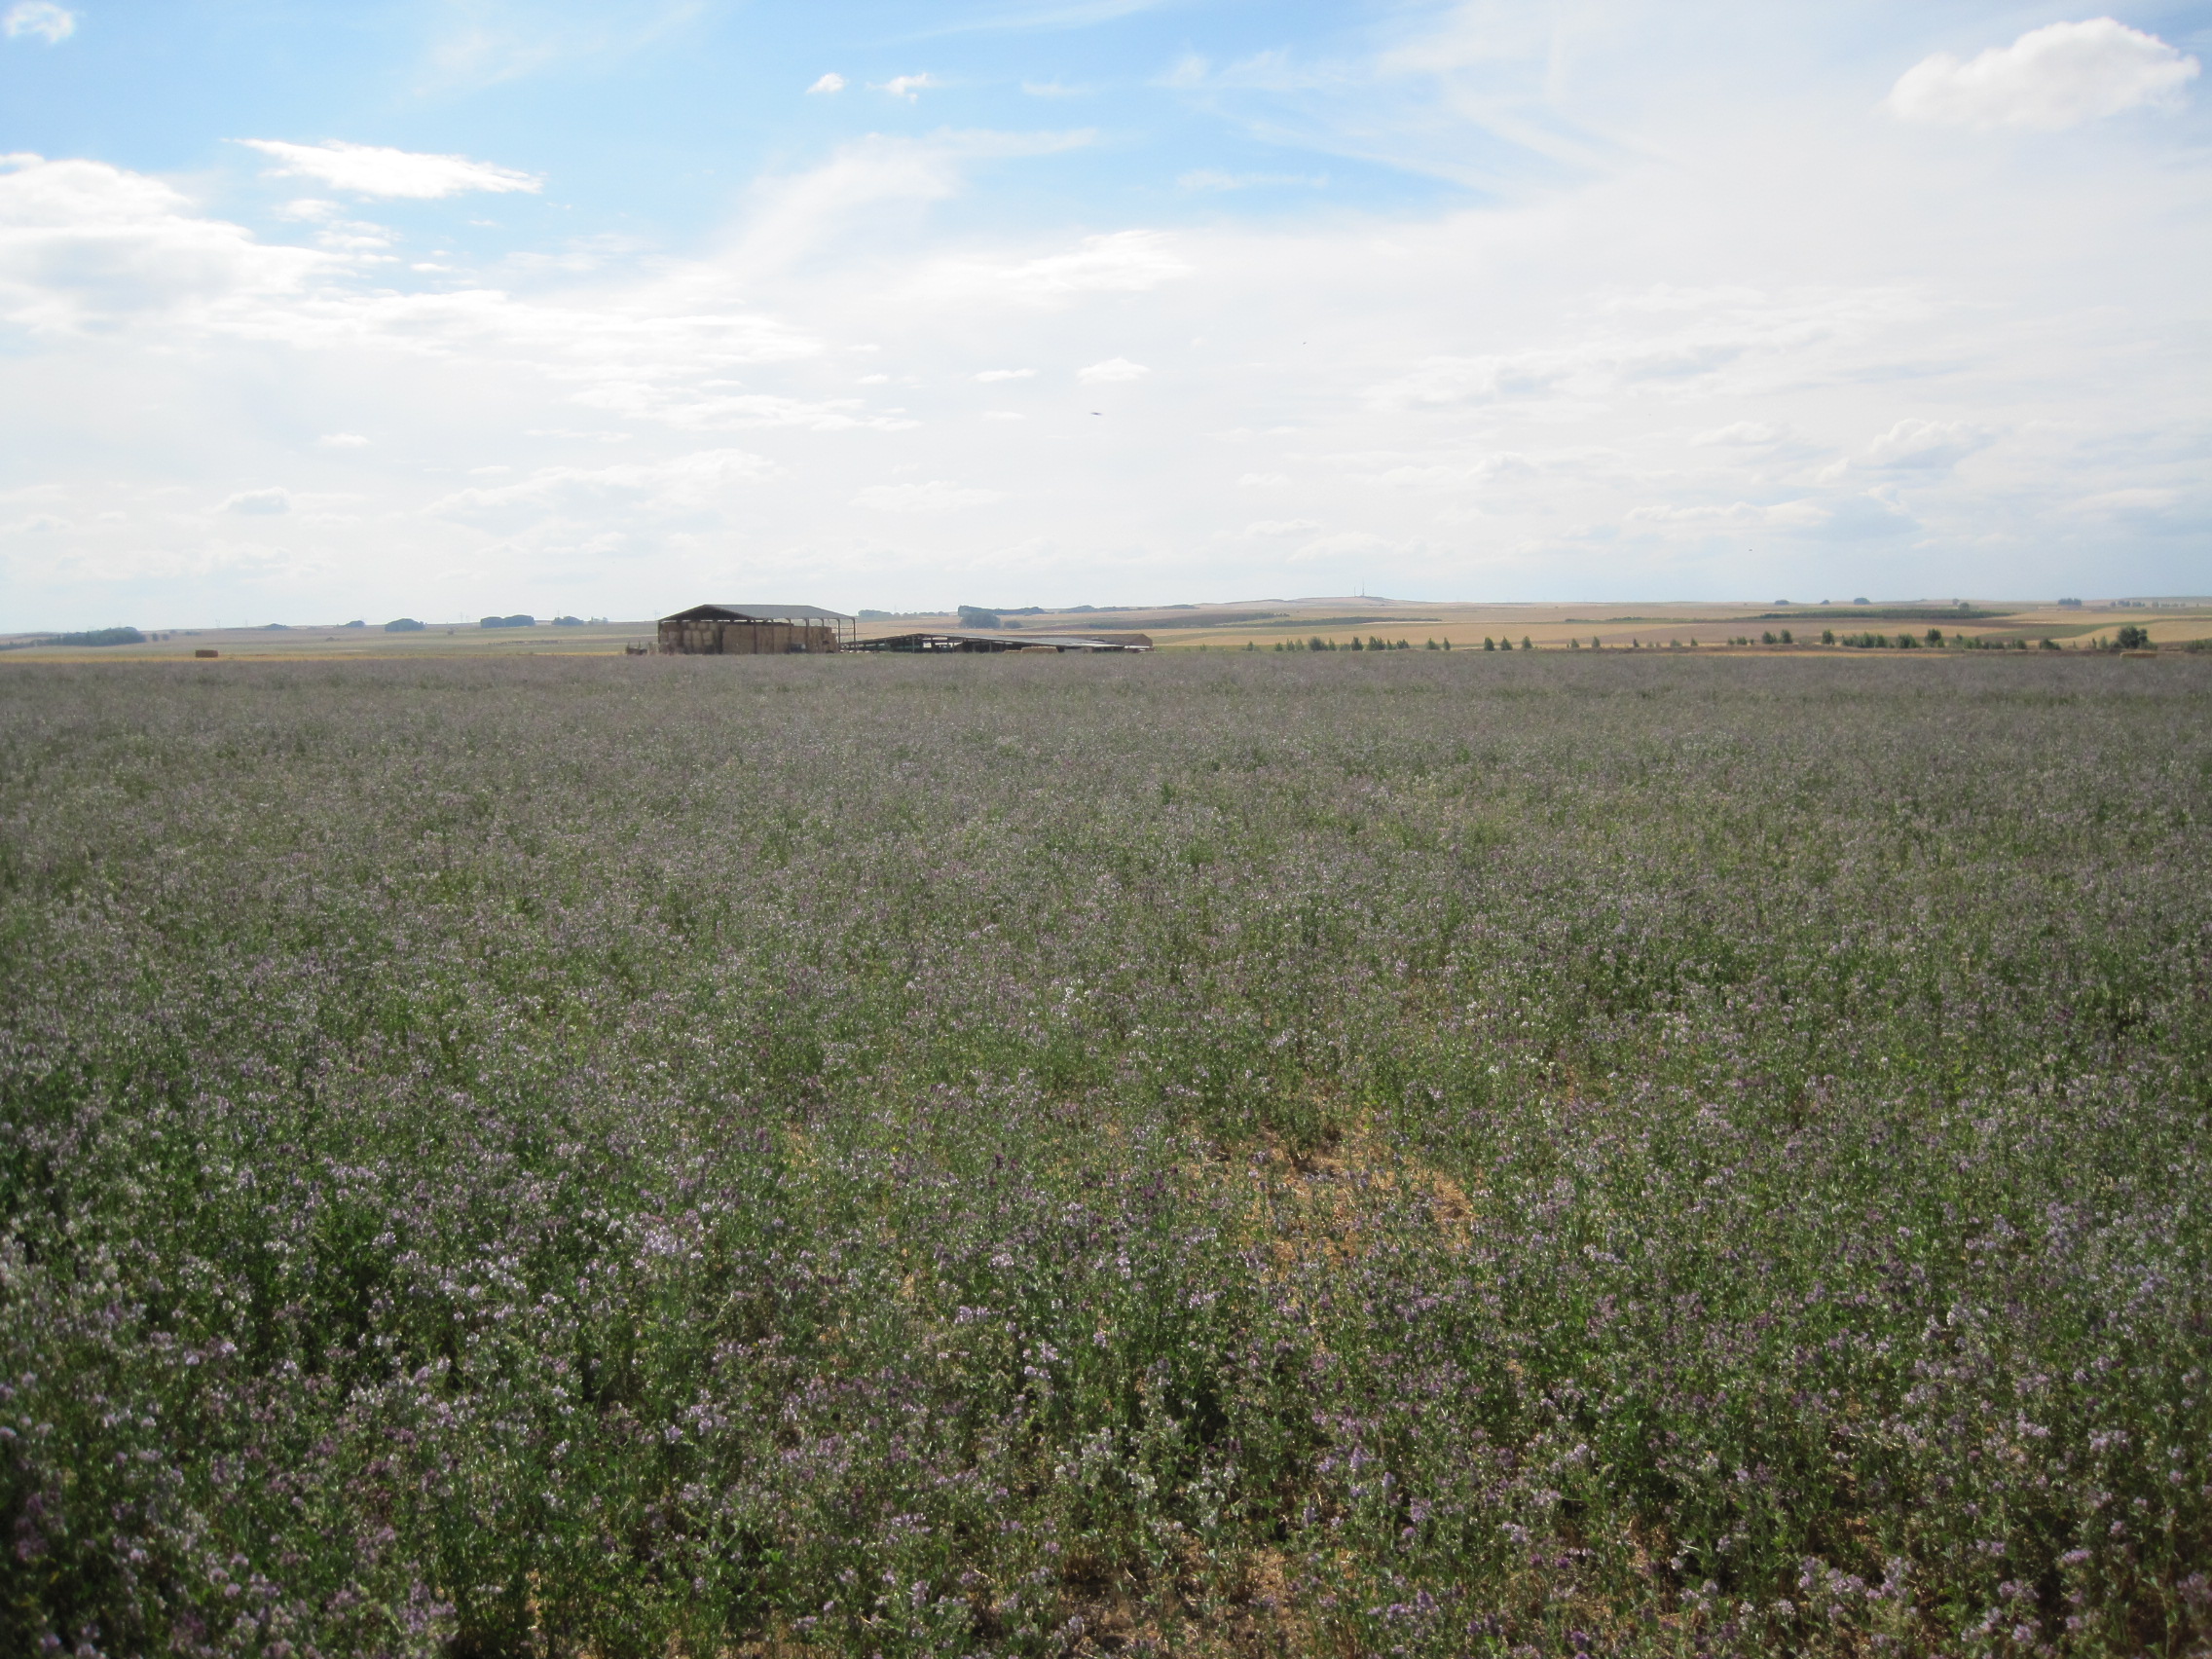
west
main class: Cropland
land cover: Lucerne
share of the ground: > 75 %
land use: Agriculture (excluding fallow land and kitchen gardens)
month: July
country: ES
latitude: 42.0000
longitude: -5.2835
